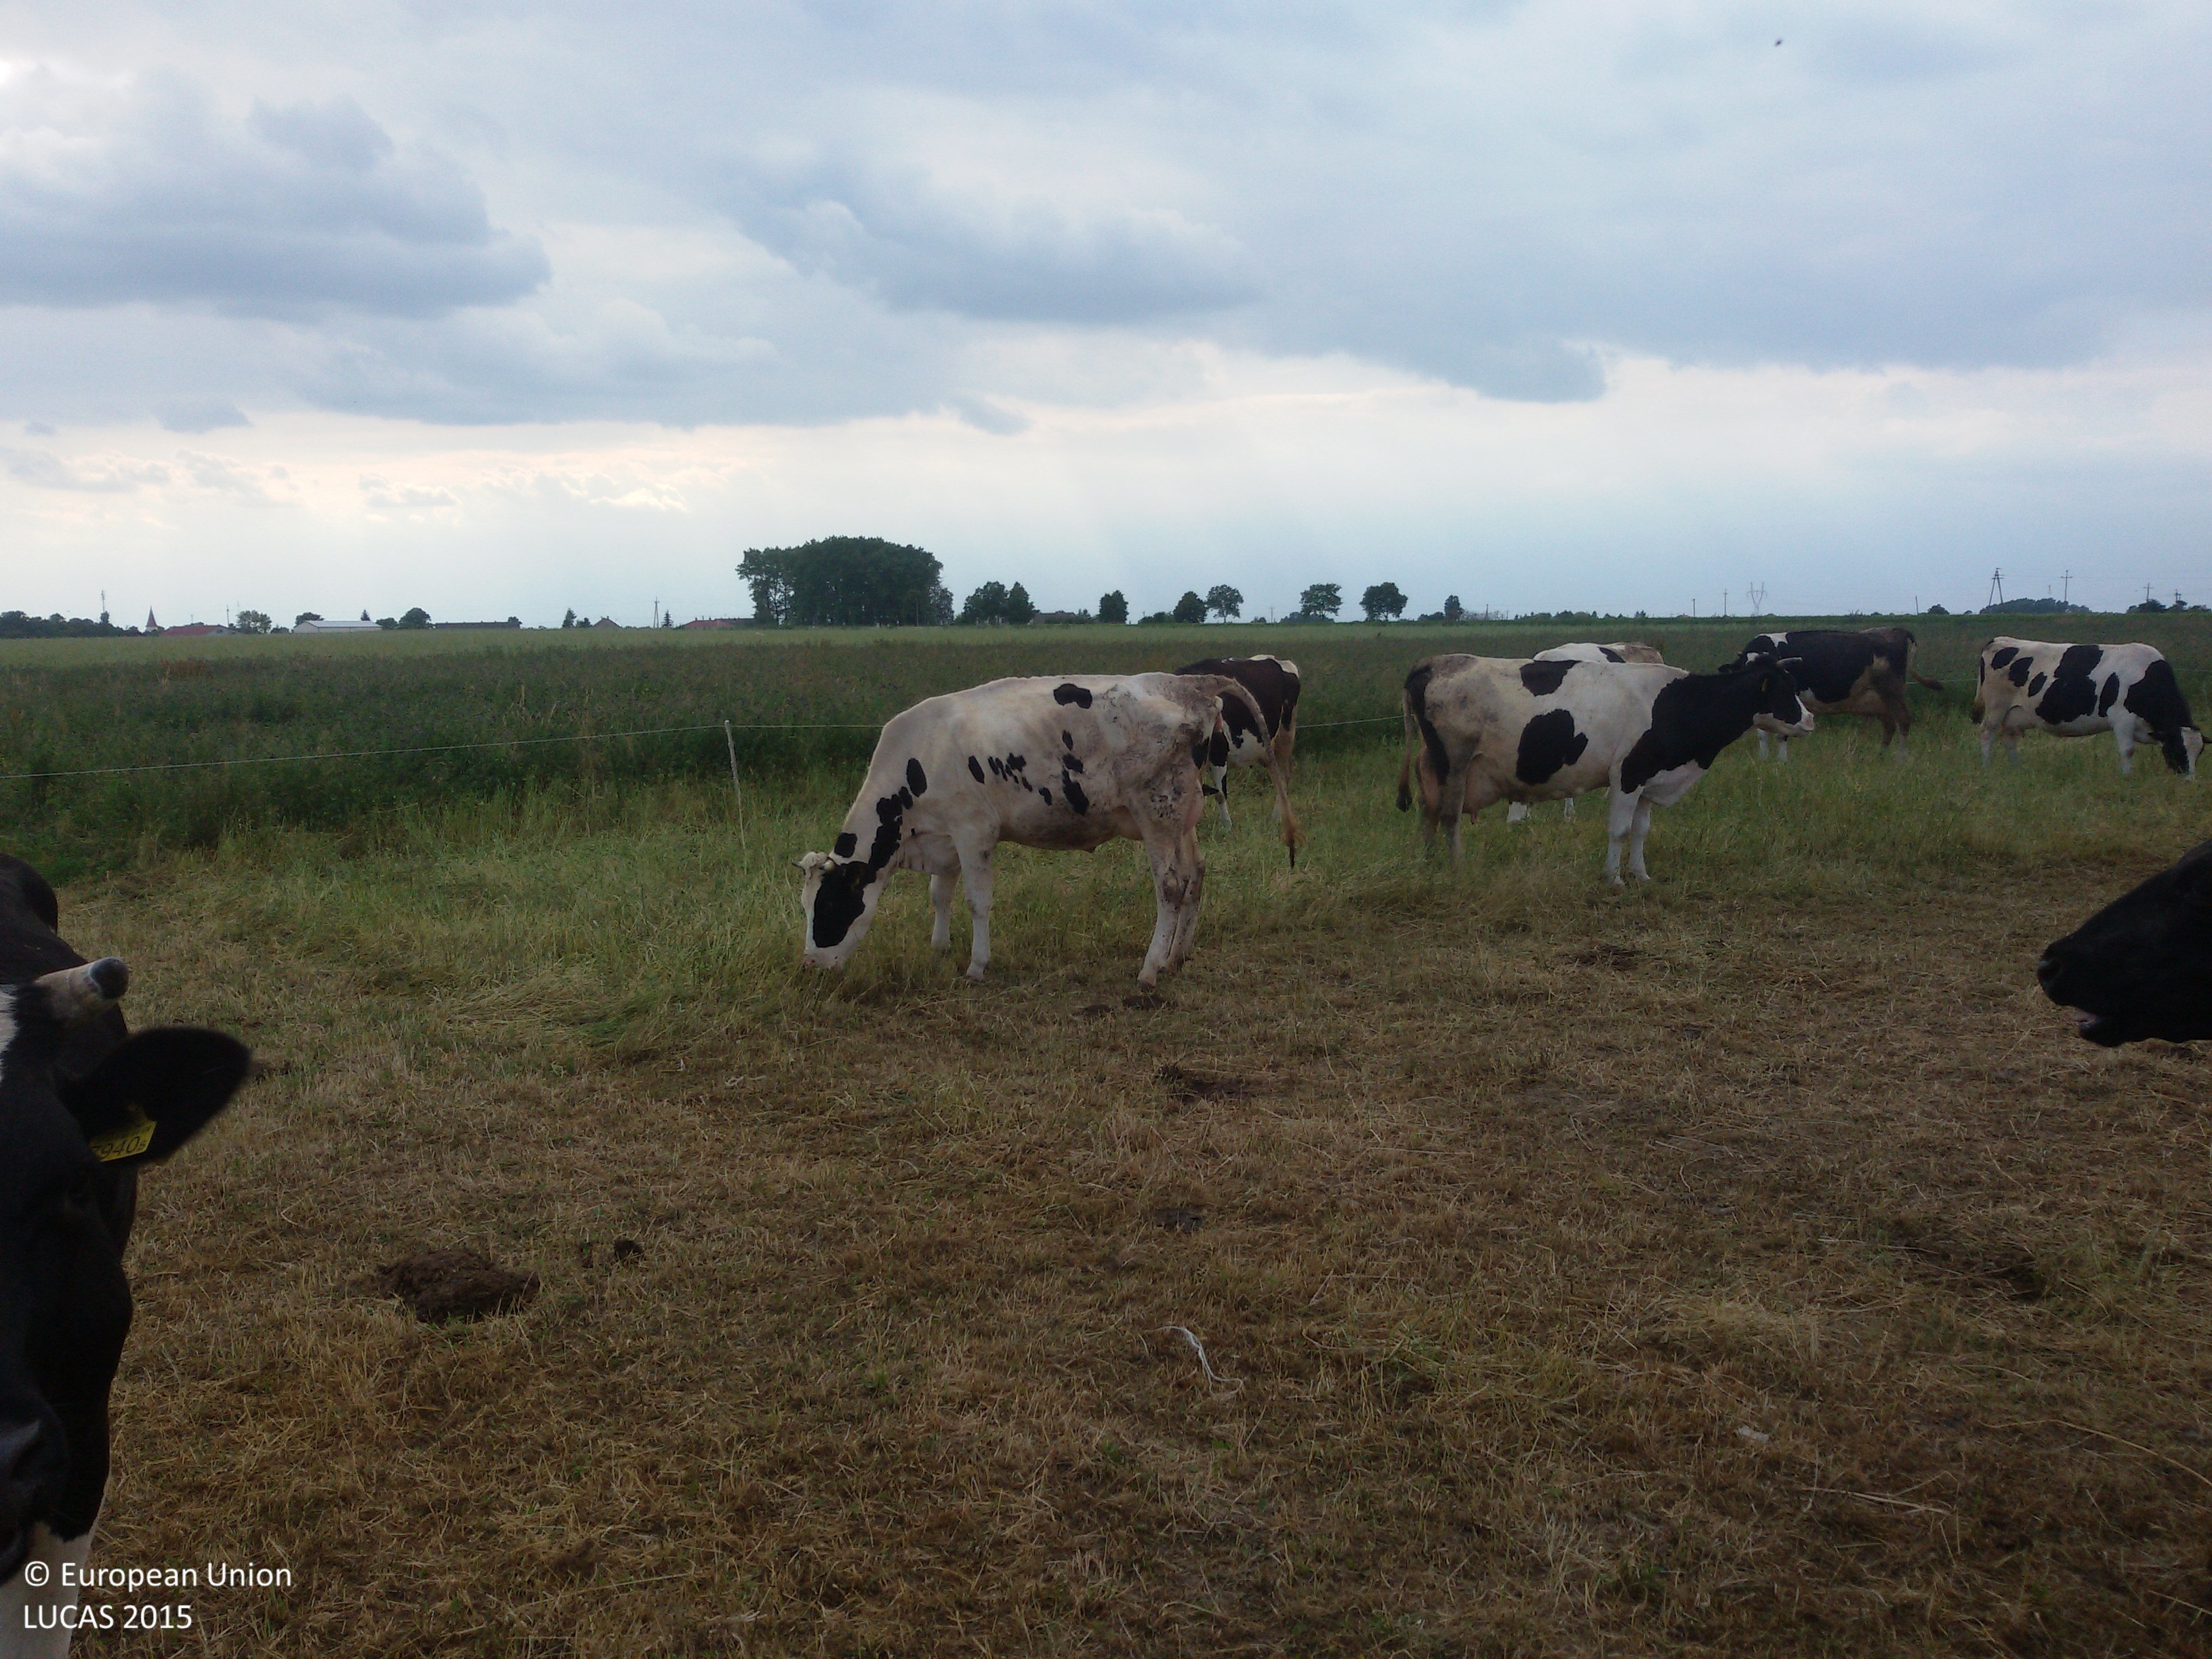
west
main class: Grassland
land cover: Grassland without tree/shrub cover
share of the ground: > 75 %
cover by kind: herbaceous plants 100 %
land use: Agriculture (excluding fallow land and kitchen gardens)
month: June
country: PL
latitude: 52.2711
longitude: 19.8941
